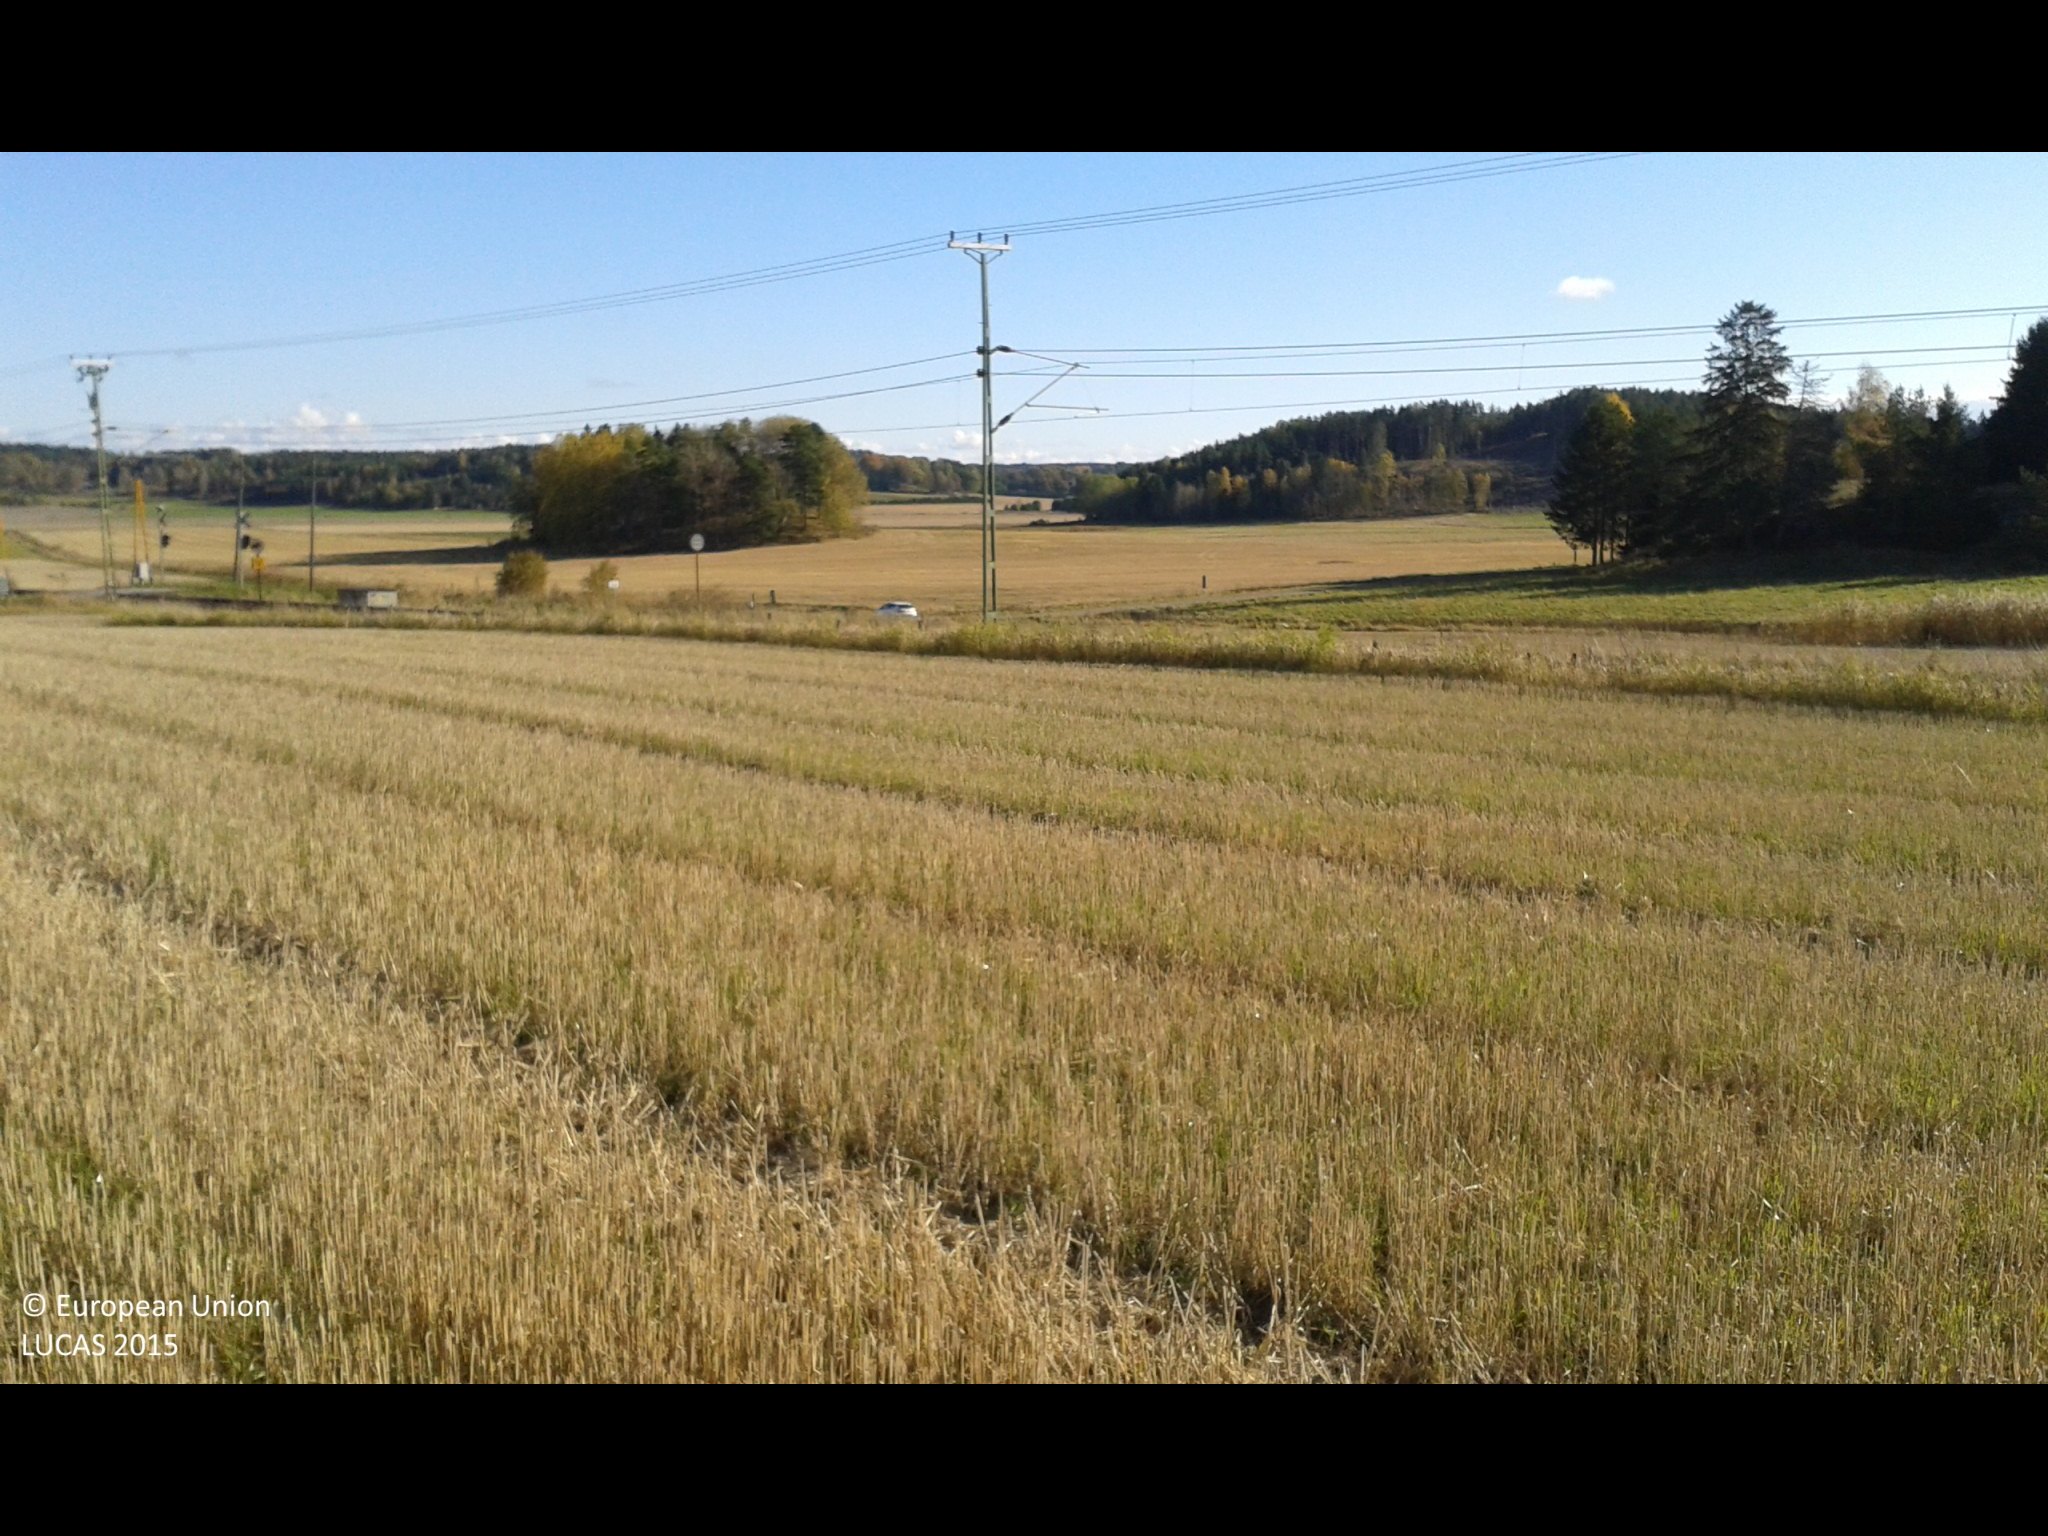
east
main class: Cropland
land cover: Barley
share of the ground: < 10 %
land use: Agriculture (excluding fallow land and kitchen gardens)
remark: Harvested field
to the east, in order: Barley; Grassland without tree/shrub cover; Fences; Grass margins; Electric lines; Railways; Grassland without tree/shrub cover; Barley; Grass margins; Tracks; Grass margins; Ditches and canals; Grass margins; Barley
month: October
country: SE
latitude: 58.8545
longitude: 17.2603
